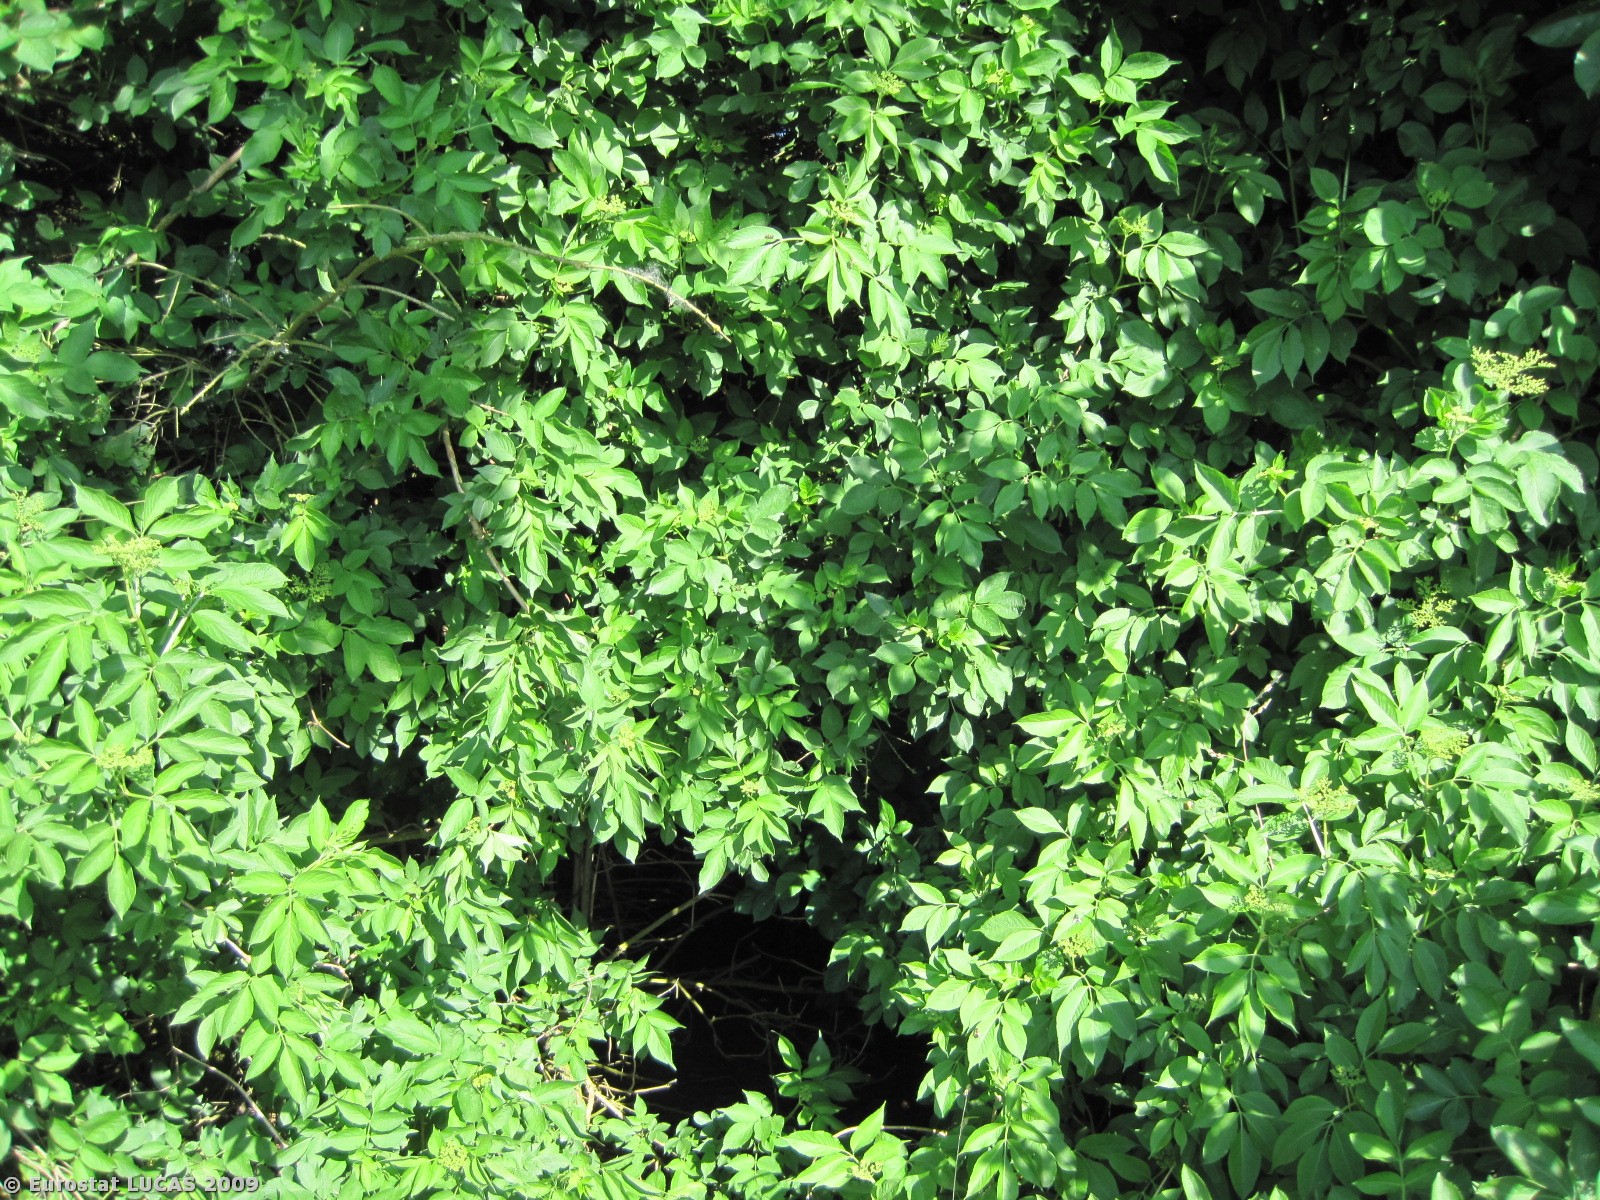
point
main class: Woodland
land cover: Mixed woodland
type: plantations and self-sown exotic forest
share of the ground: > 75 %
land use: Unused
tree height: > 5 m
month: May
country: DK
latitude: 56.5830
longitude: 10.2439
